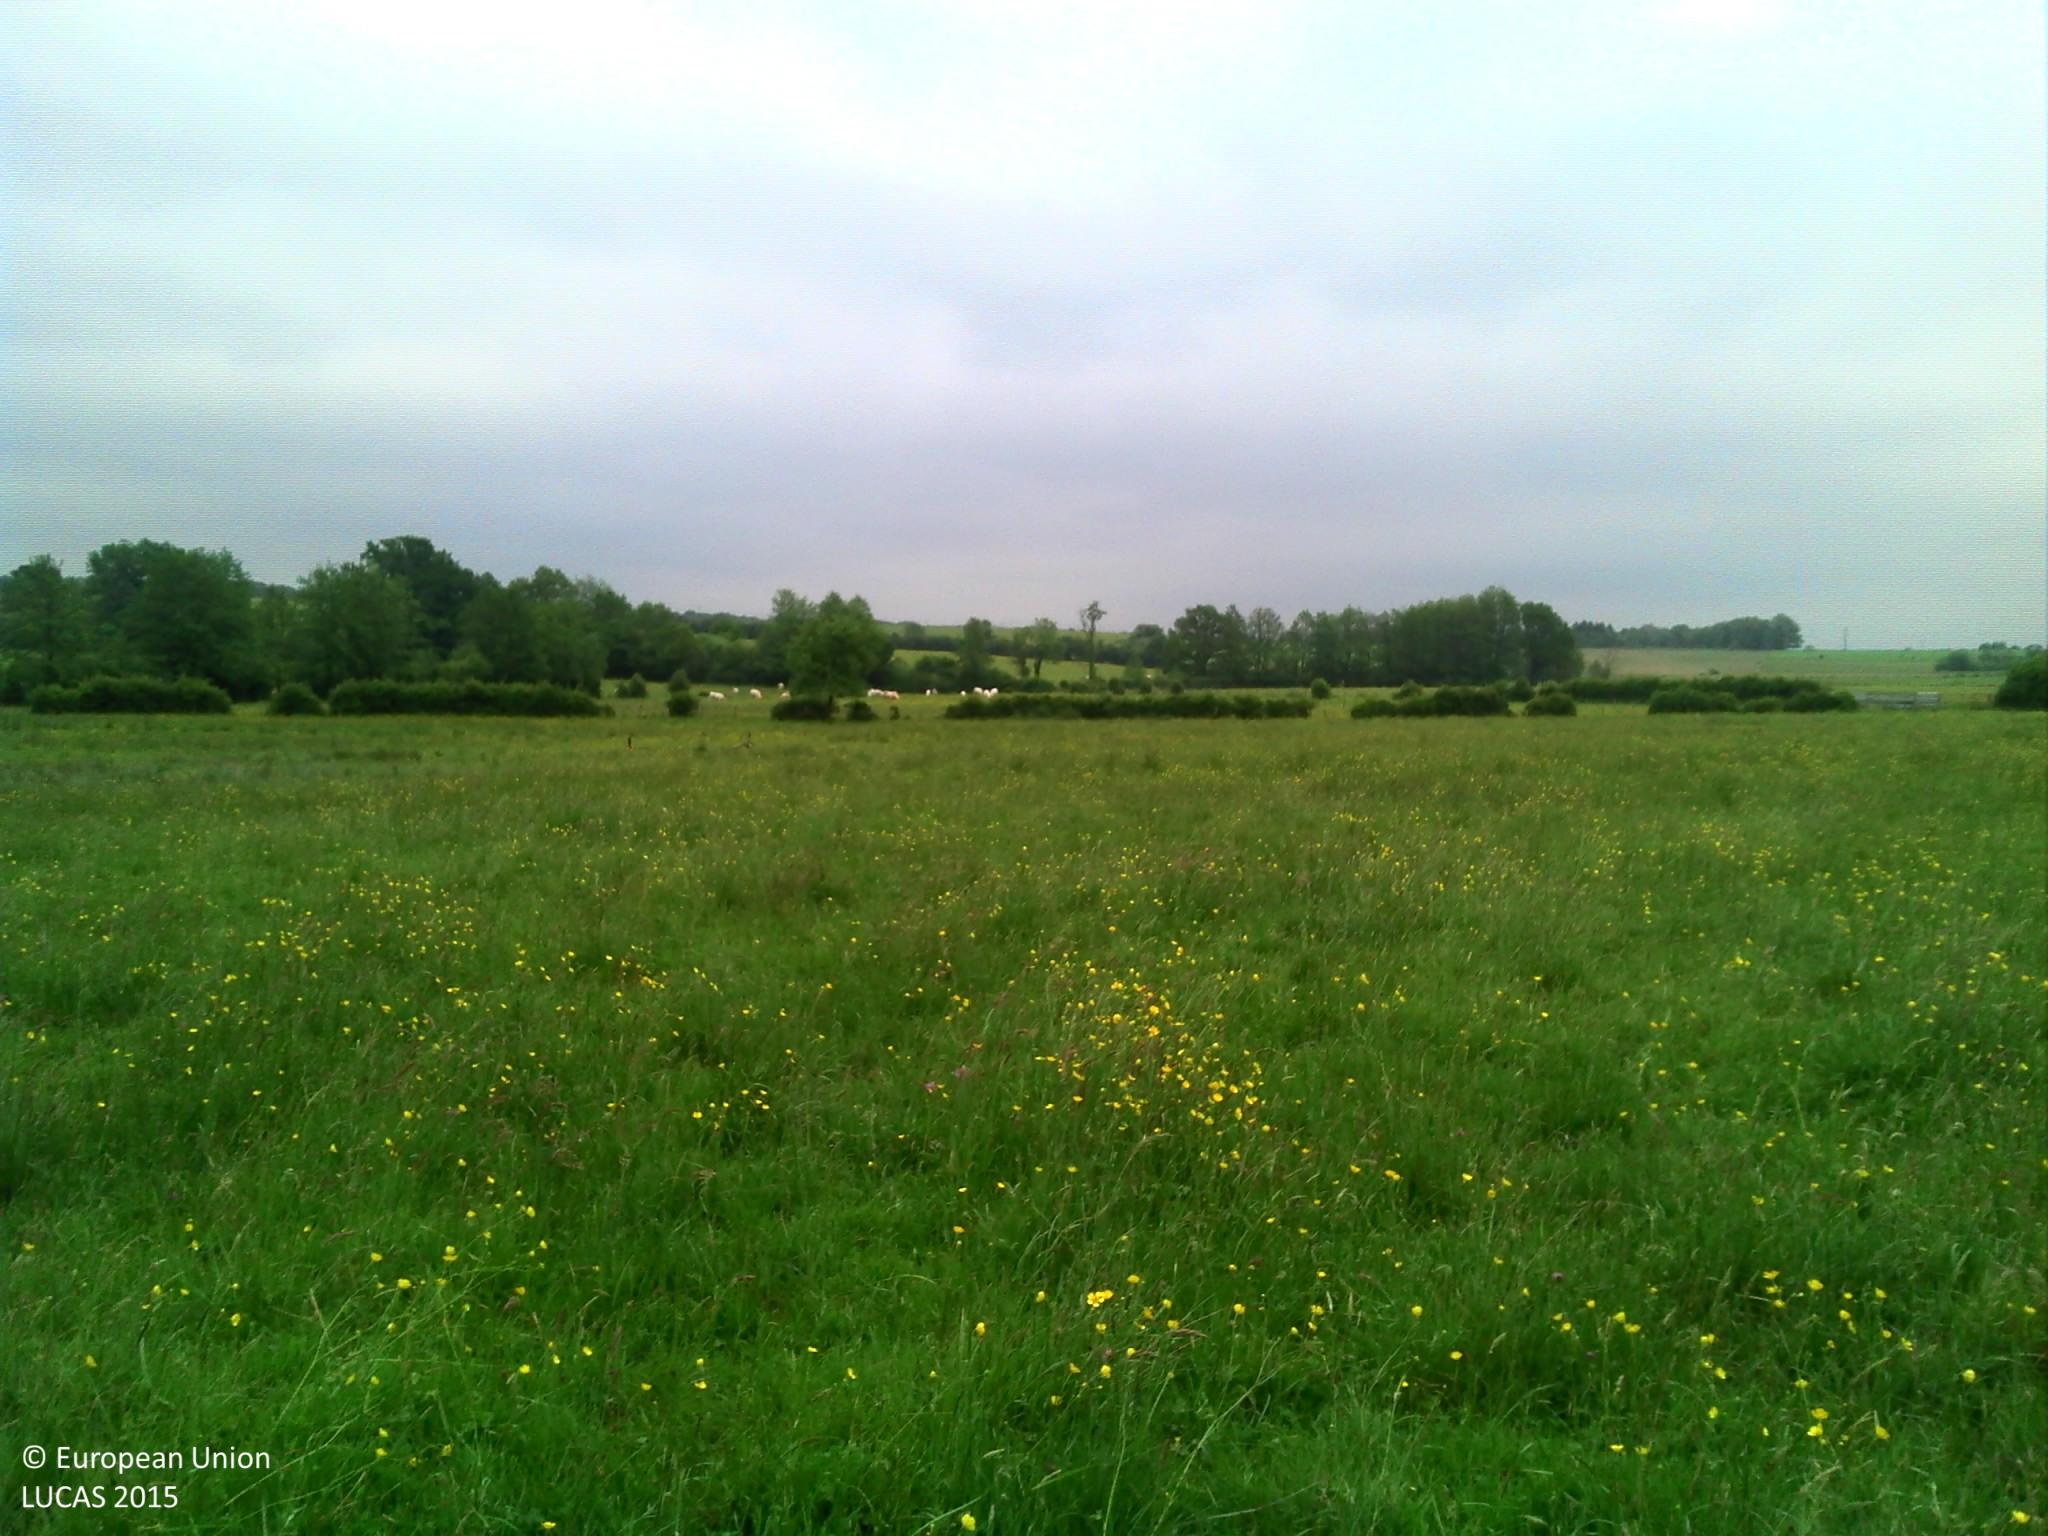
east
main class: Grassland
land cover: Grassland with sparse tree/shrub cover
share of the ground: > 75 %
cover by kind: herbaceous plants 95 %, broadleaved forest trees 5 %
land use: Agriculture (excluding fallow land and kitchen gardens)
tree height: > 5 m
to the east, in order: Grassland with sparse tree/shrub cover; Ditches and canals; Abandoned hedges; Fences; Grassland without tree/shrub cover; Fences; Grassland without tree/shrub cover; Abandoned hedges; Fences; Grass margins; Tracks; Grass margins; Ditches and canals; Fences; Grassland without tree/shrub cover
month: May
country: FR
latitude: 47.9405
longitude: 6.1587
